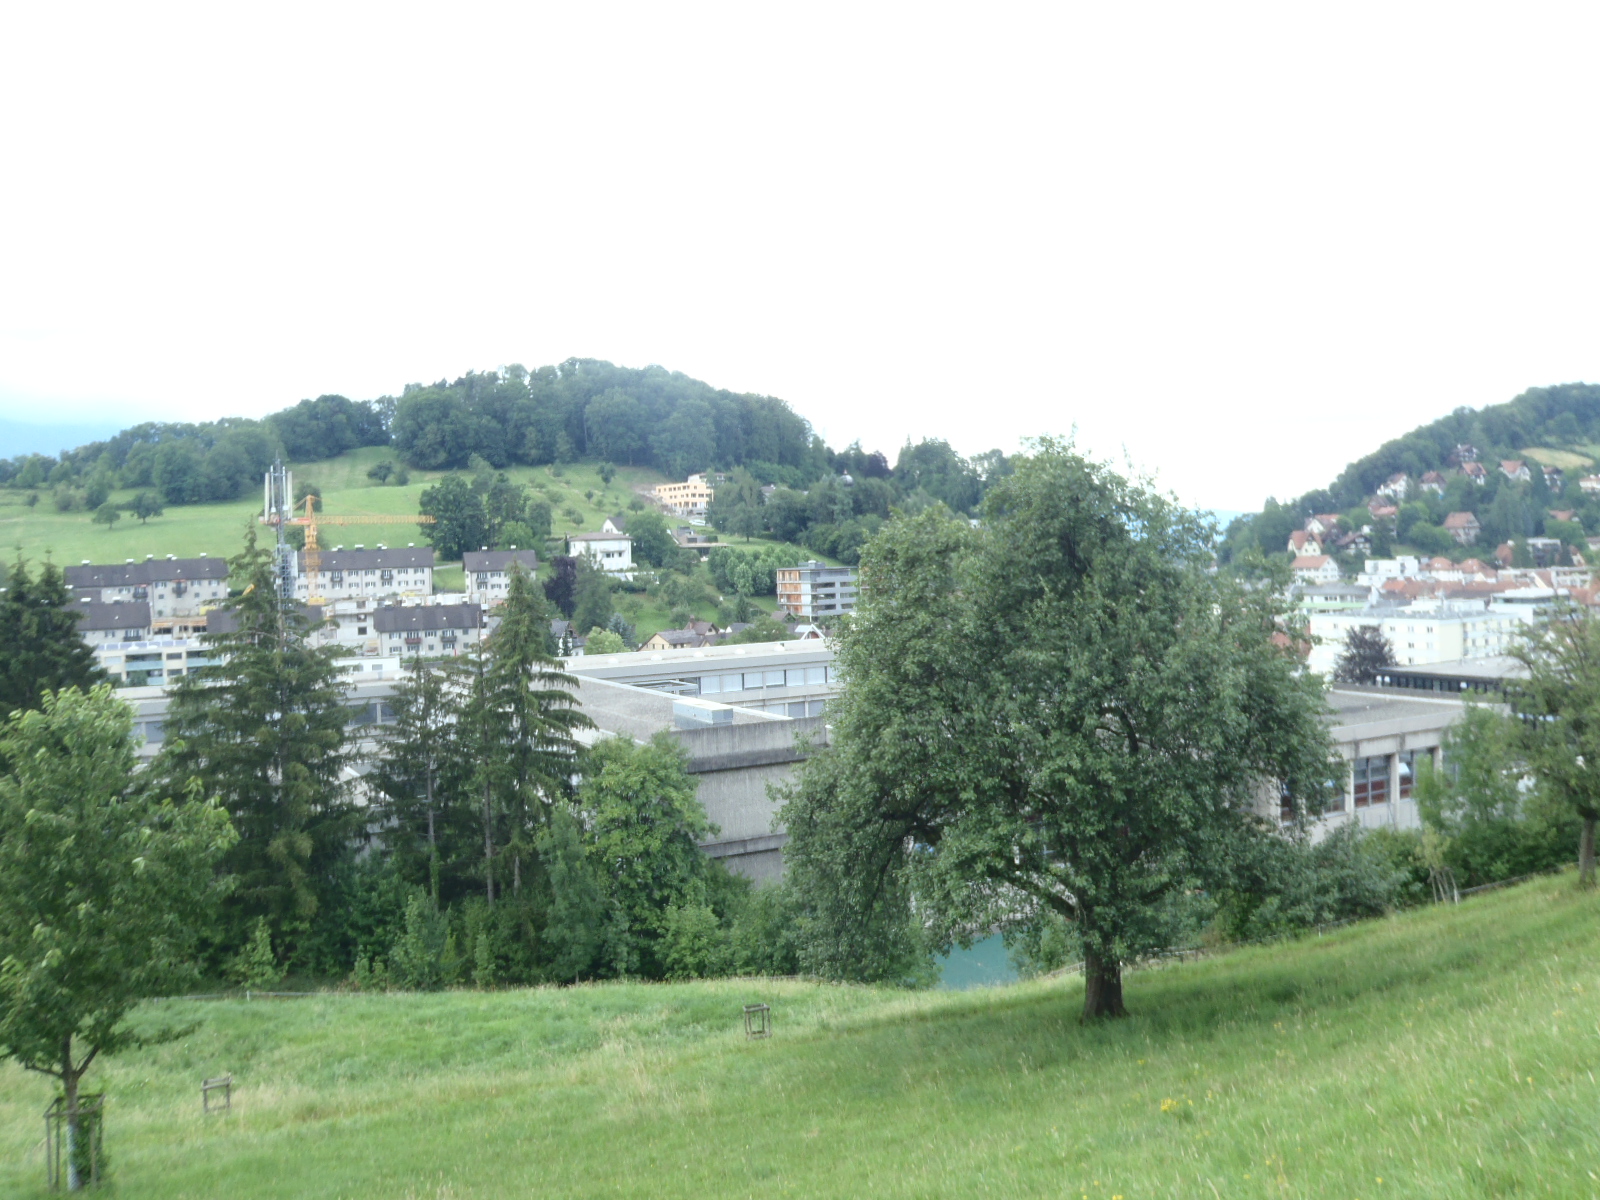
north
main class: Grassland
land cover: Grassland without tree/shrub cover
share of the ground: > 75 %
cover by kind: herbaceous plants 100 %
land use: Agriculture (excluding fallow land and kitchen gardens)
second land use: Amenities, museums, leisure
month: July
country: AT
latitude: 47.2328
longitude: 9.5909
